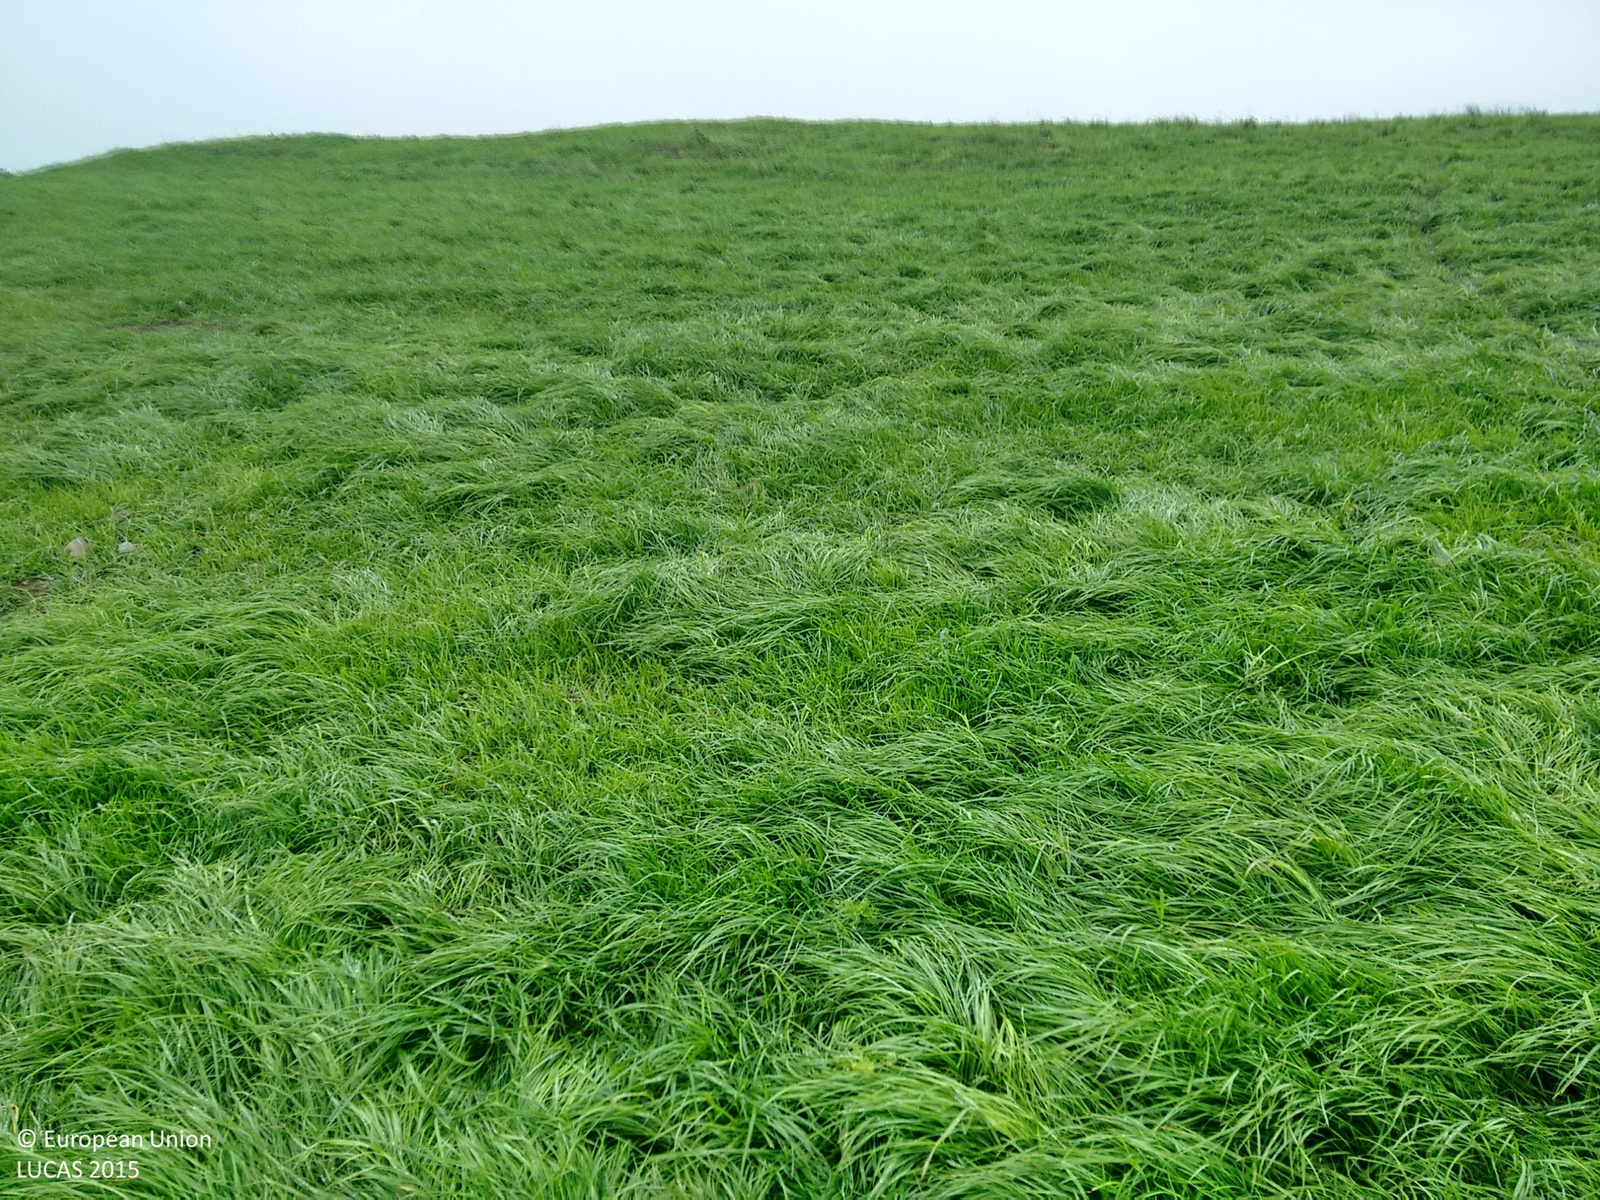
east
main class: Grassland
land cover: Grassland without tree/shrub cover
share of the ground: > 75 %
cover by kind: herbaceous plants 100 %
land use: Agriculture (excluding fallow land and kitchen gardens)
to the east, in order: Grassland without tree/shrub cover; Fences; Dry stone walls; Grass margins; Paved roads, cycling and walking lanes; Grass margins; Dry stone walls; Fences; Grassland without tree/shrub cover
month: July
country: GB
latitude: 54.7994
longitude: -4.1091
